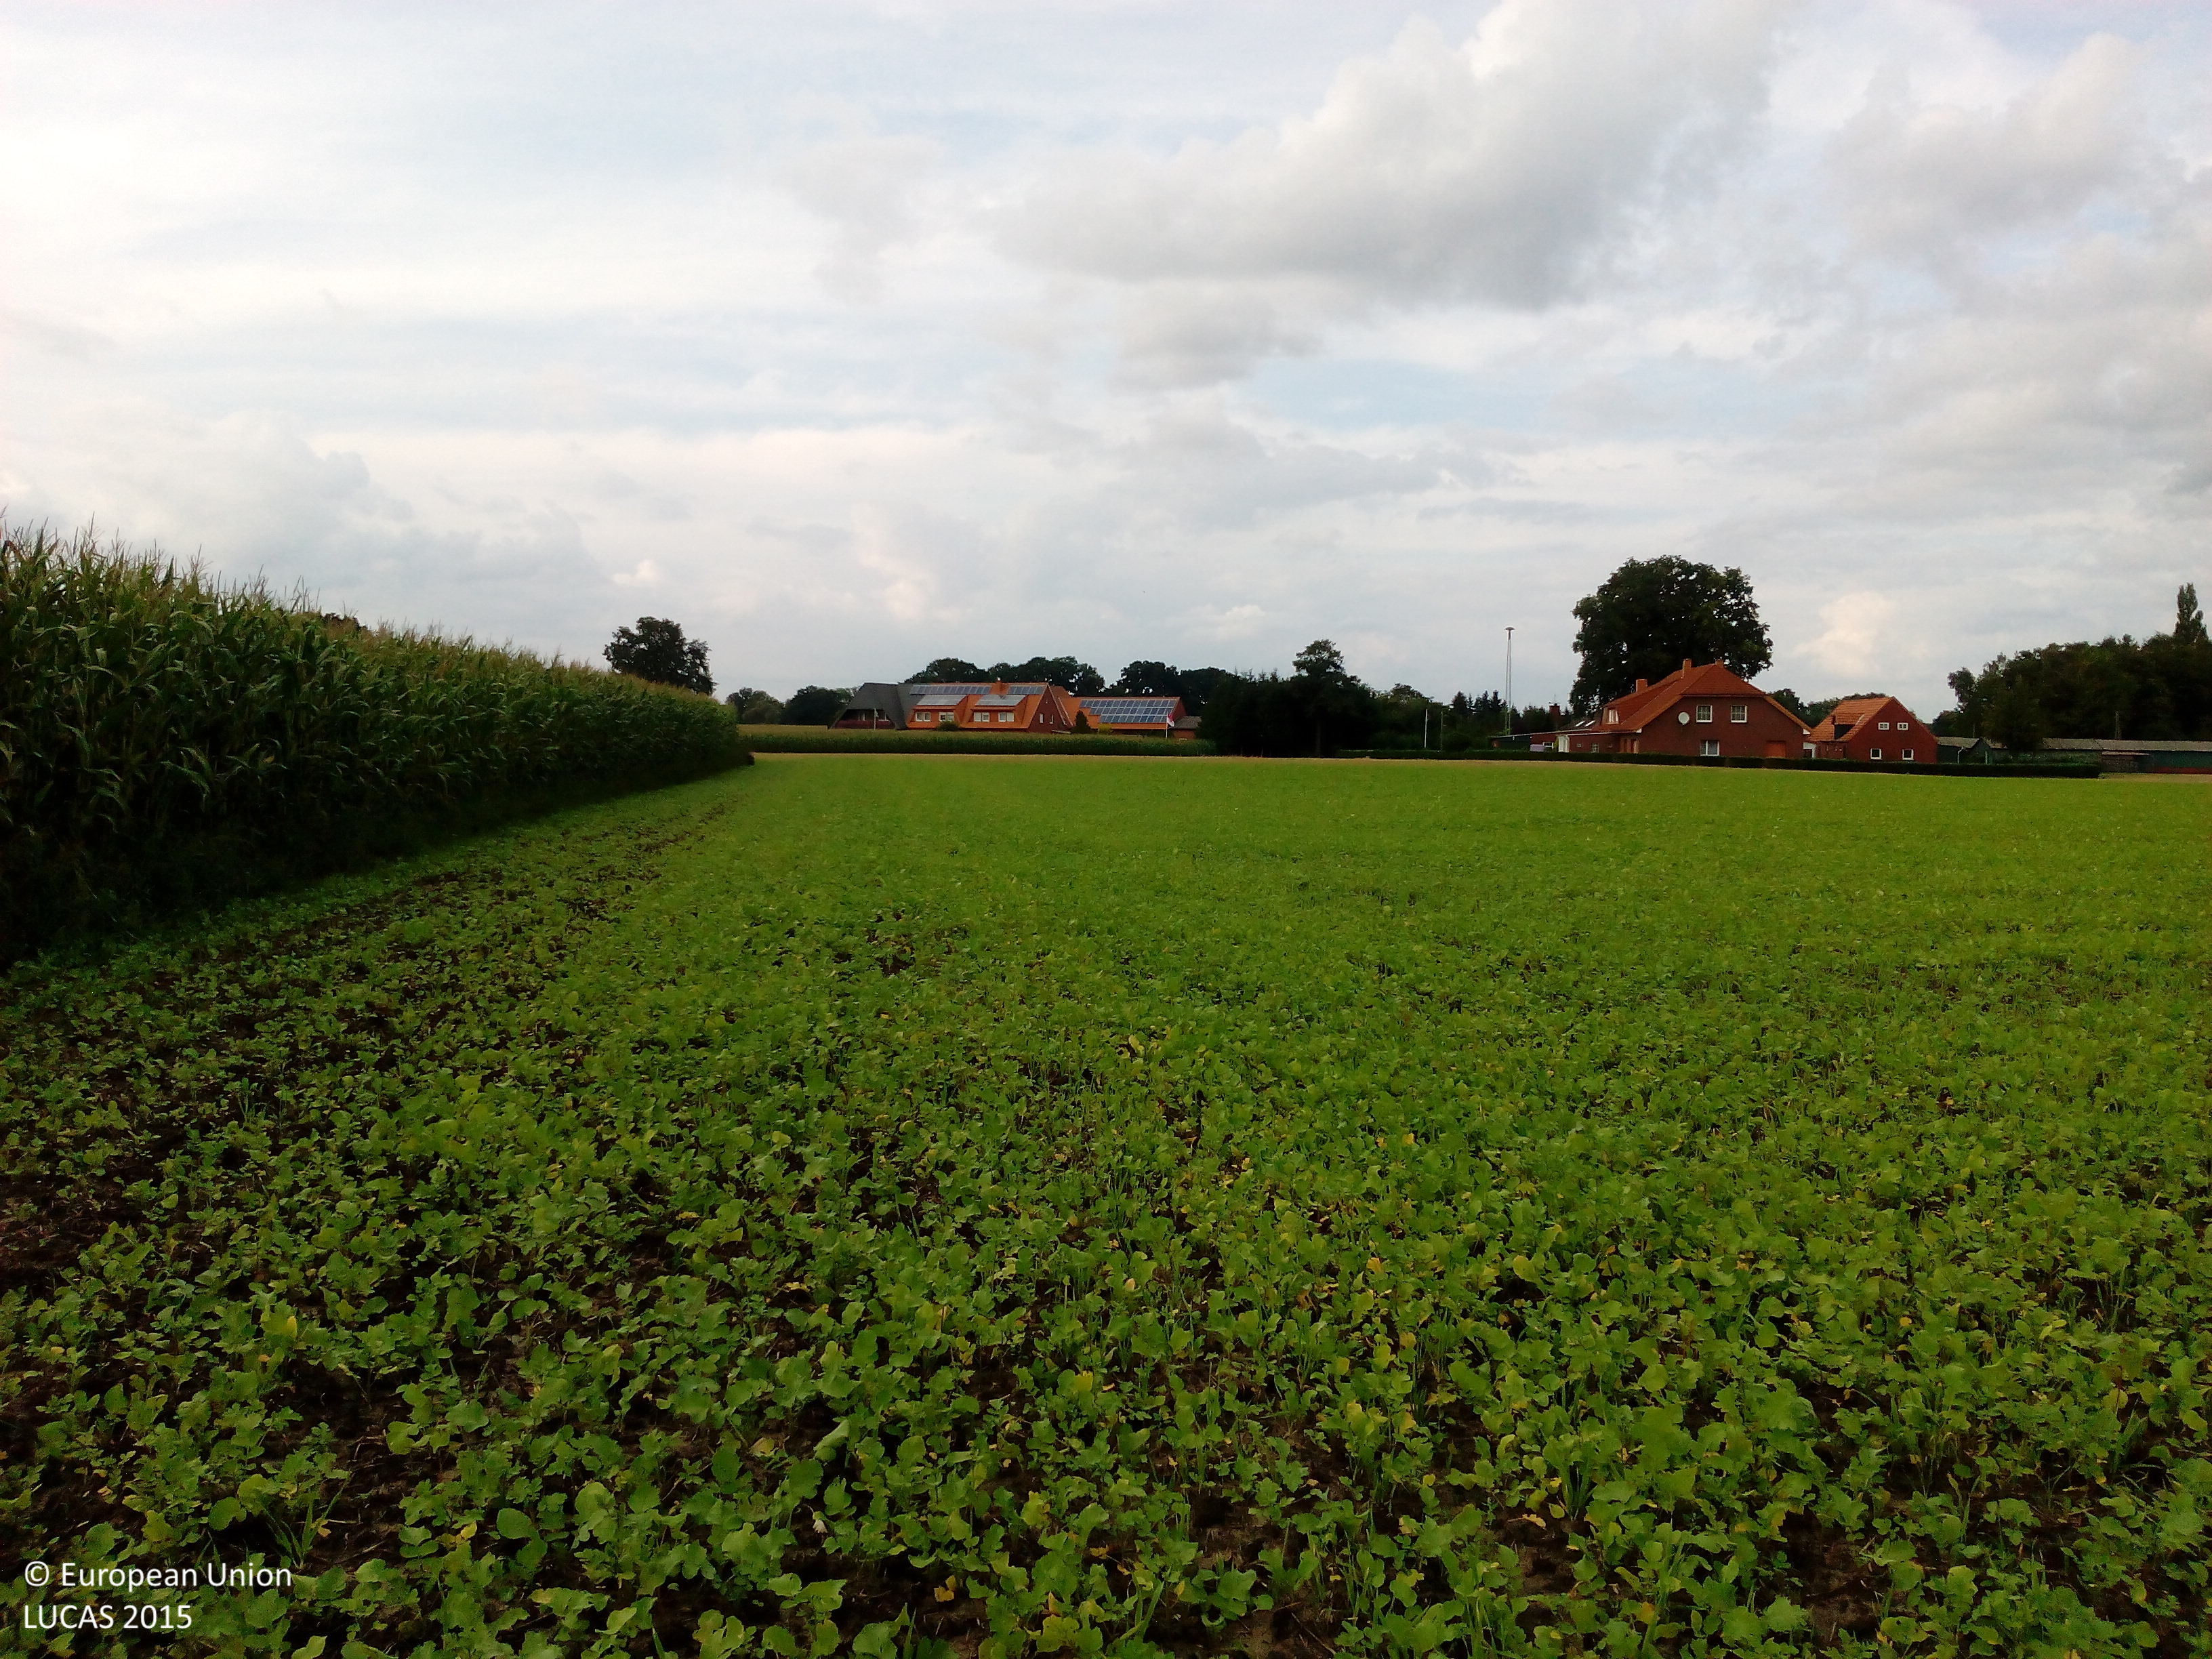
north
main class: Grassland
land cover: Spontaneously vegetated surfaces
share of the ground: > 75 %
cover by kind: herbaceous plants 100 %
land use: Agriculture (excluding fallow land and kitchen gardens)
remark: Harvested field
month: August
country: DE
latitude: 52.4328
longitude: 8.0149
